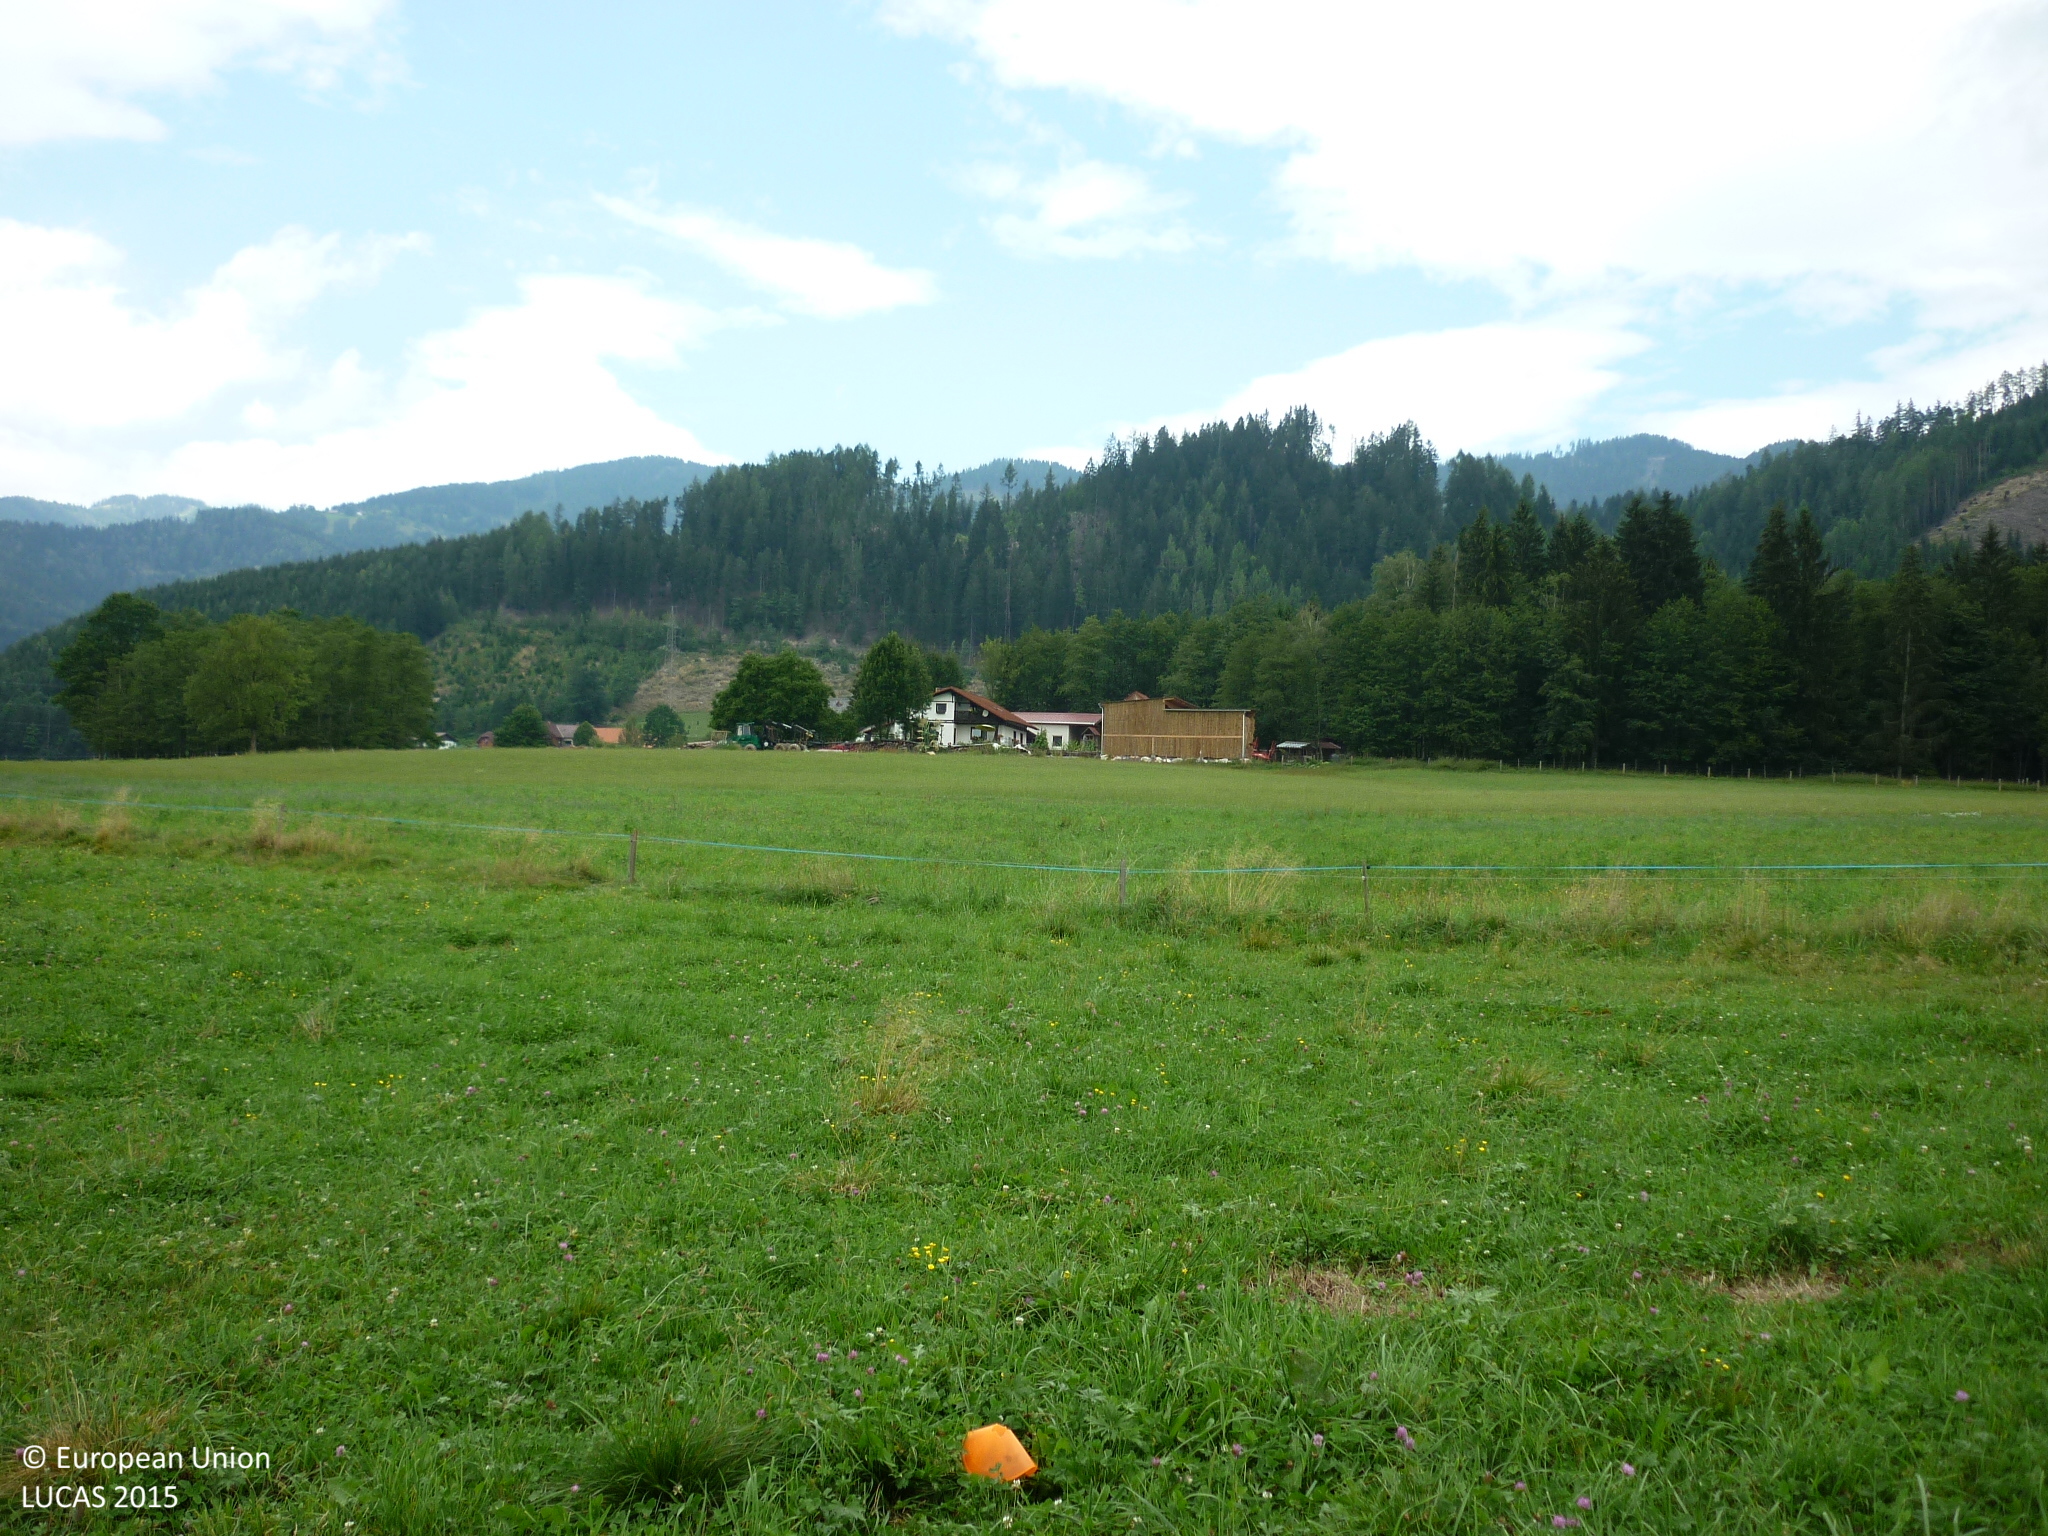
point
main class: Grassland
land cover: Grassland without tree/shrub cover
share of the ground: > 75 %
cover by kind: herbaceous plants 100 %
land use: Agriculture (excluding fallow land and kitchen gardens)
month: August
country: AT
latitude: 47.4805
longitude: 15.3485
